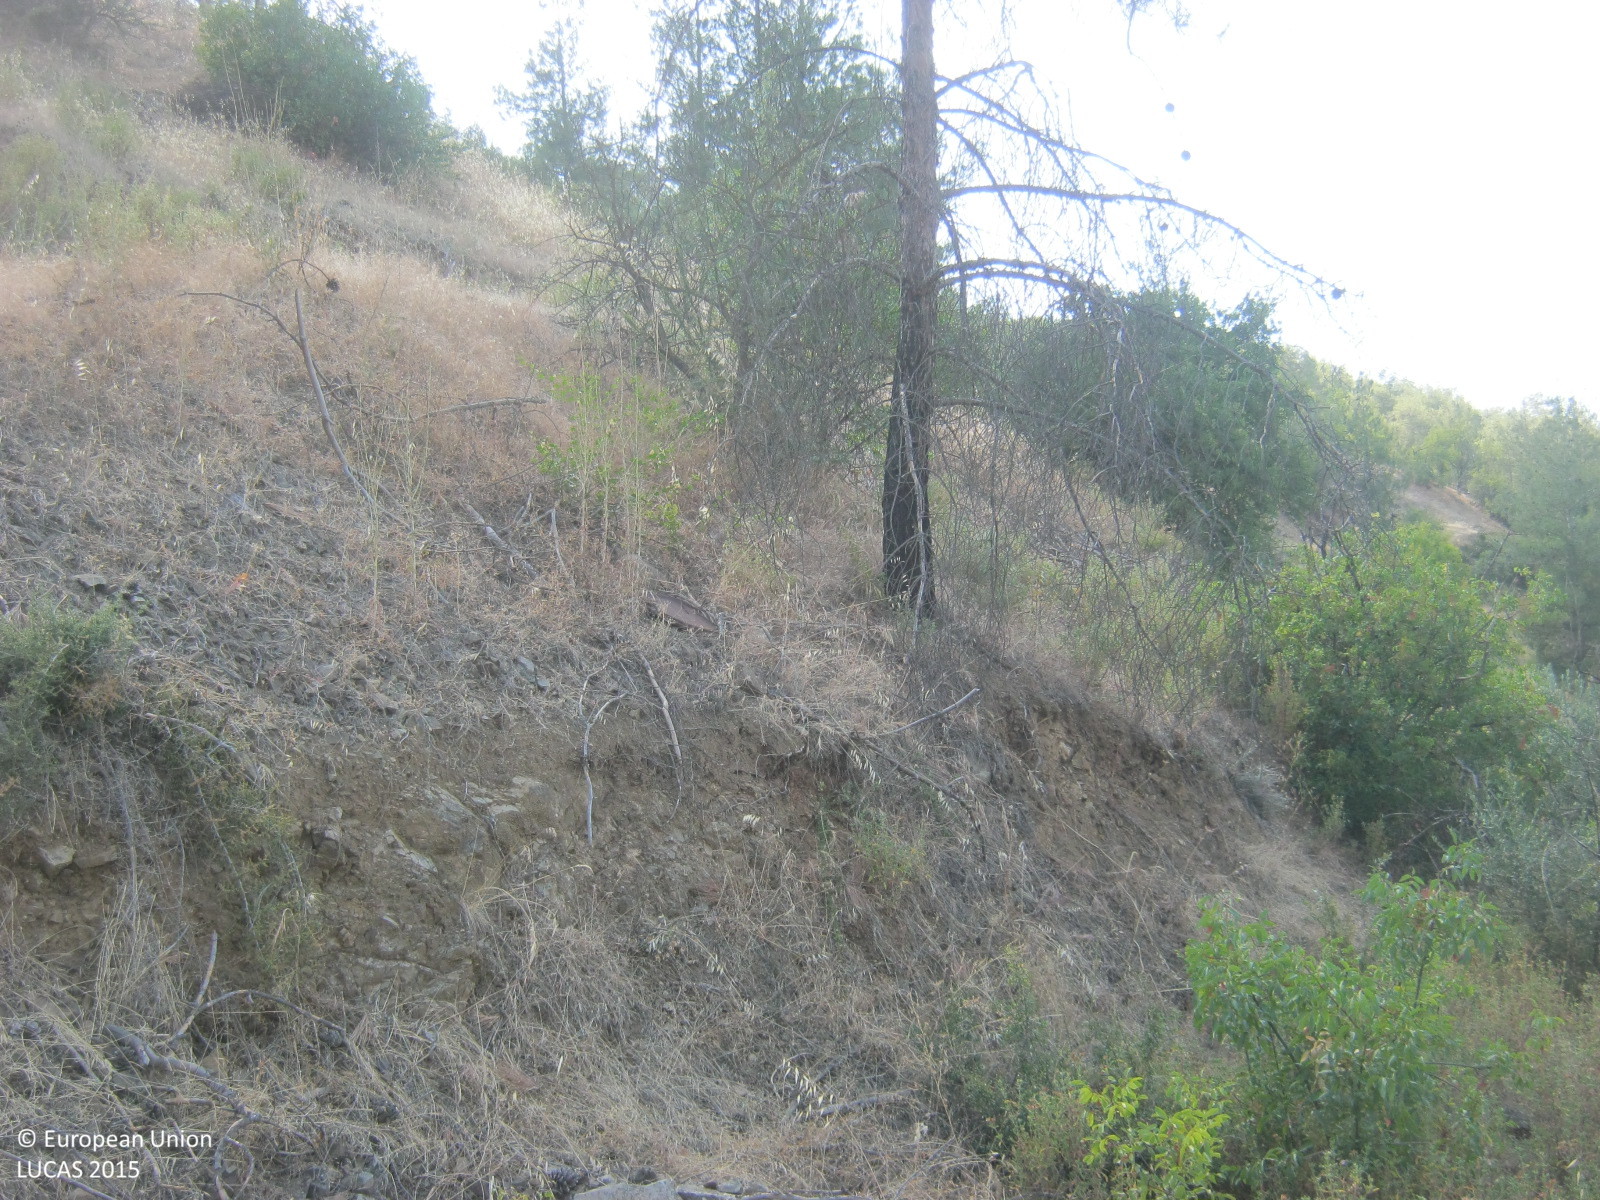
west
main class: Cropland
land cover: Olive groves
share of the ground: 25 - 50 %
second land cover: Shrubland without tree cover
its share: > 75 %
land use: Abandoned areas
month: June
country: CY
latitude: 34.9860
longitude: 33.1290
